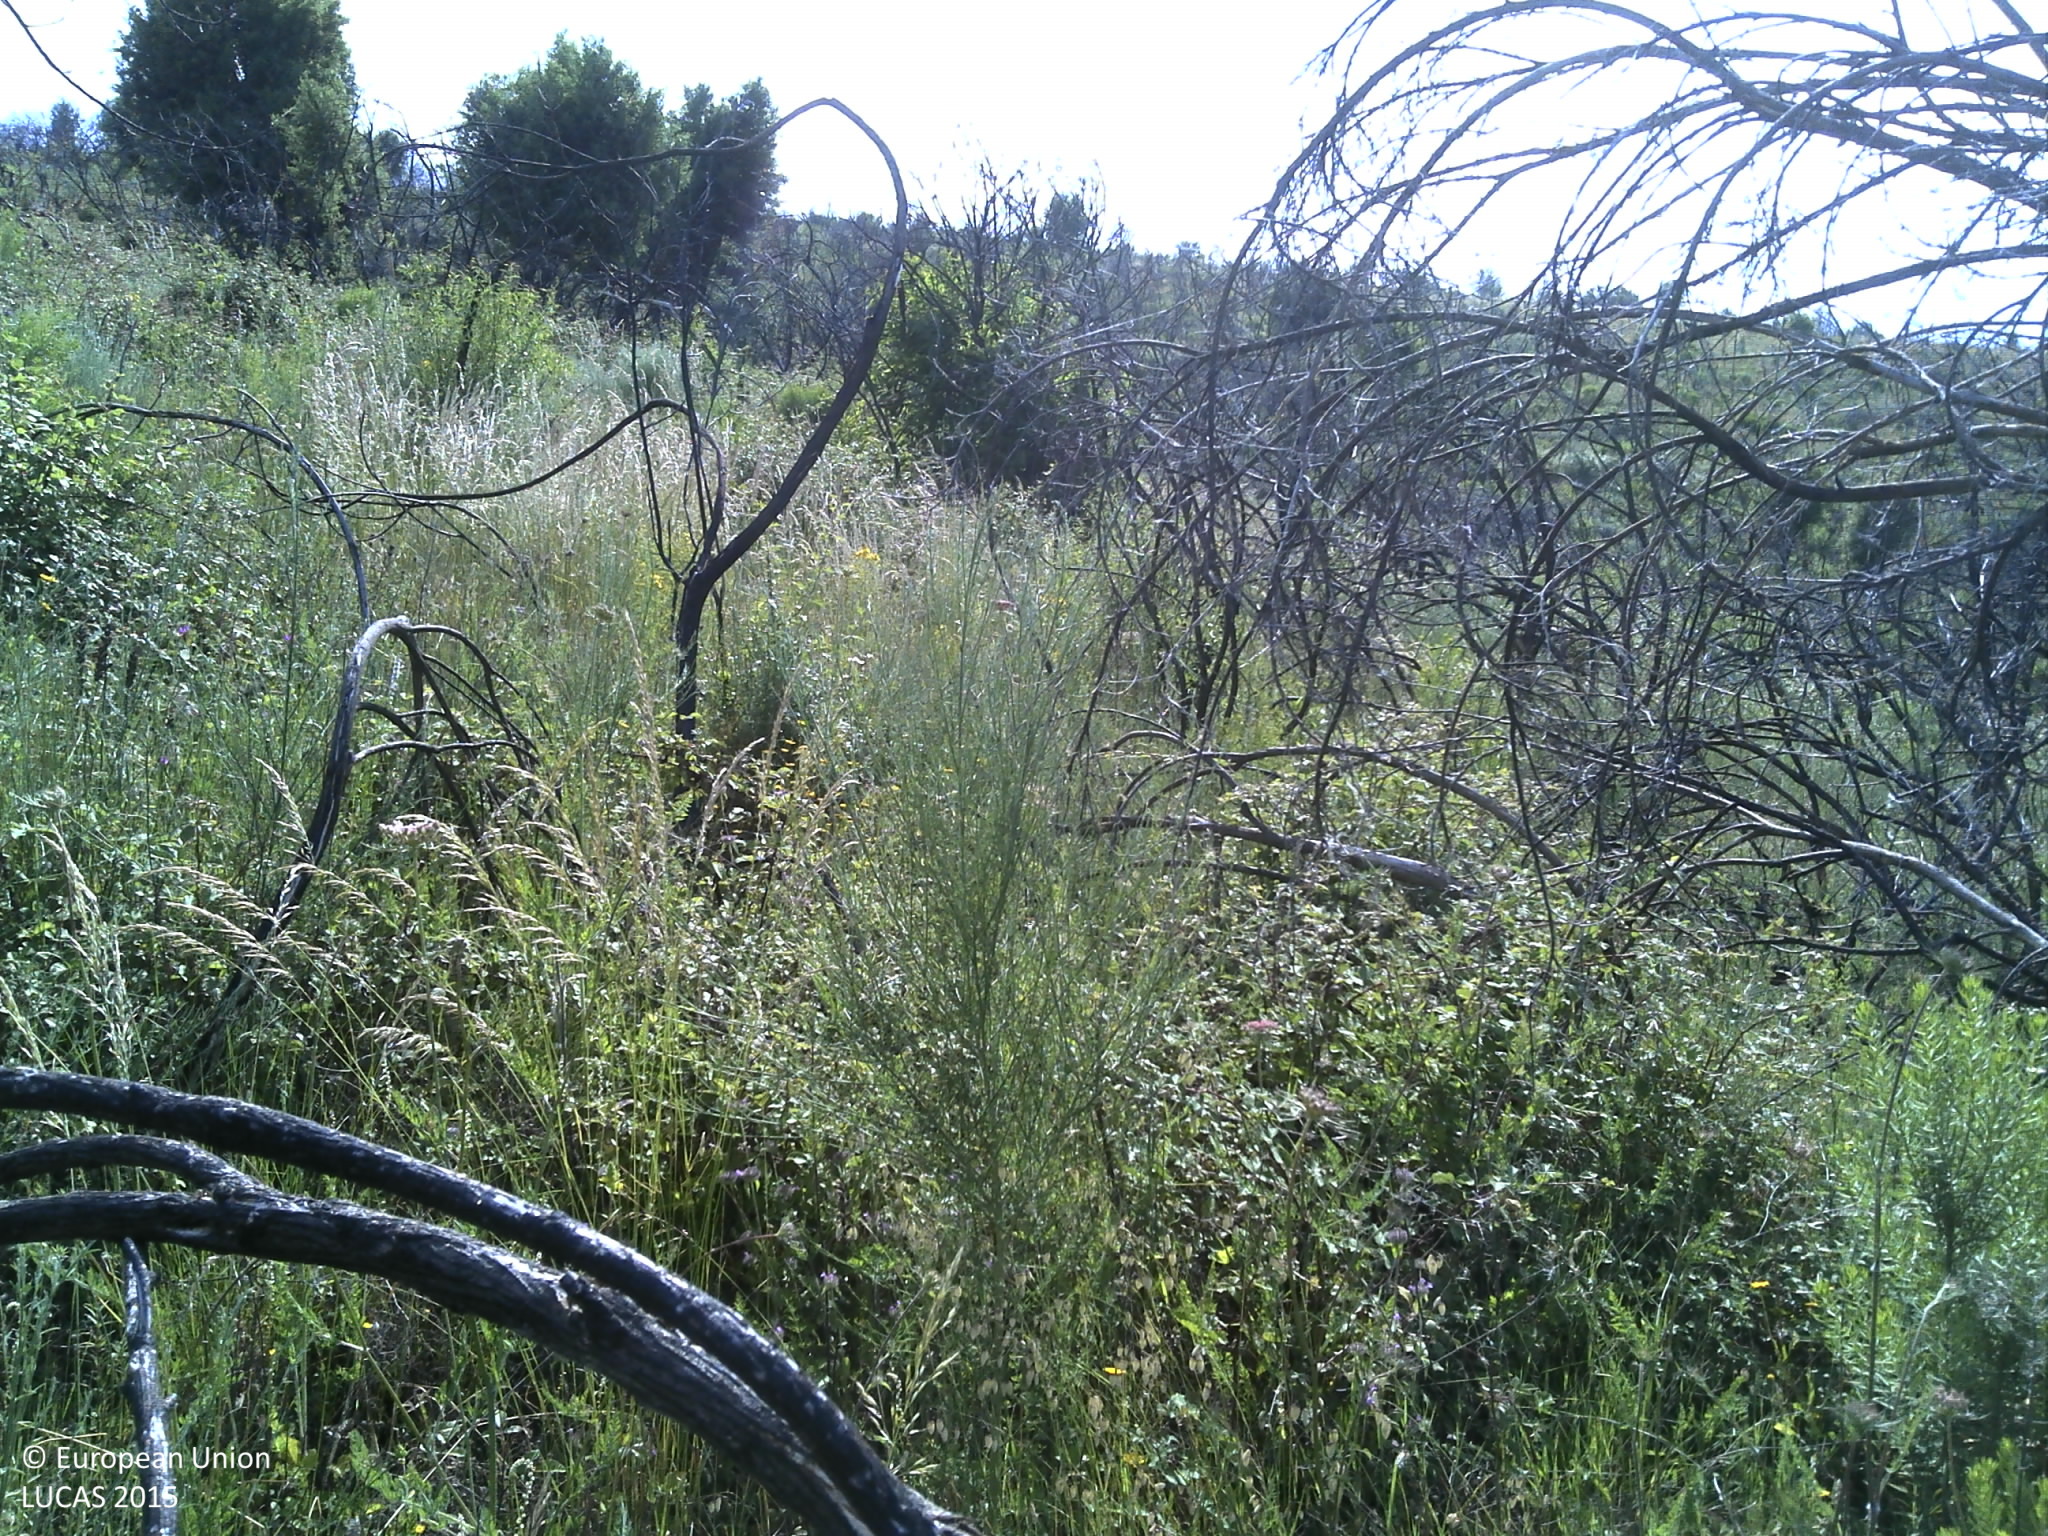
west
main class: Shrubland
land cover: Shrubland with sparse tree cover
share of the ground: 10 - 25 %
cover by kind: herbaceous plants 75 %, shrubs 20 %, broadleaved forest trees 5 %
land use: Abandoned areas
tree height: > 5 m
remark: Burnt area
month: May
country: PT
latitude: 41.2272
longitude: -6.8682
